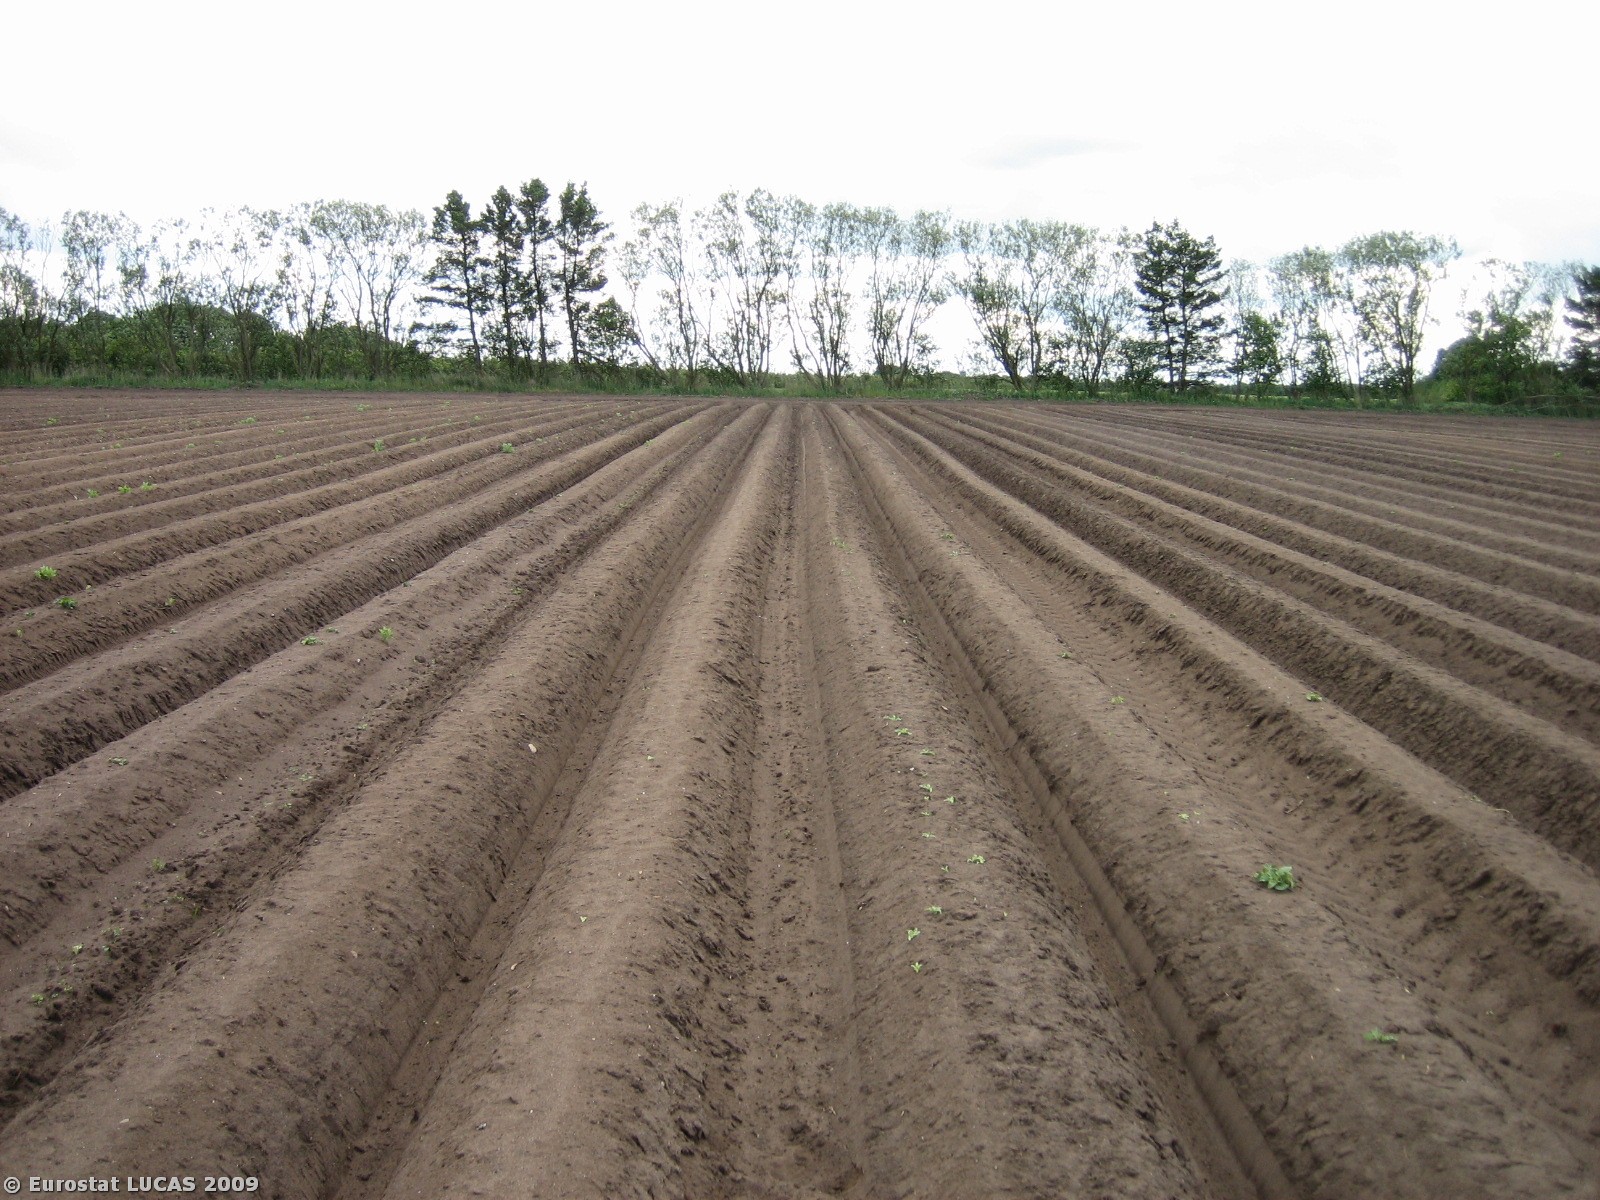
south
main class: Cropland
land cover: Potatoes
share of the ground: < 10 %
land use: Agriculture (excluding fallow land and kitchen gardens)
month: June
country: DK
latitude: 56.0241
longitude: 9.3109
